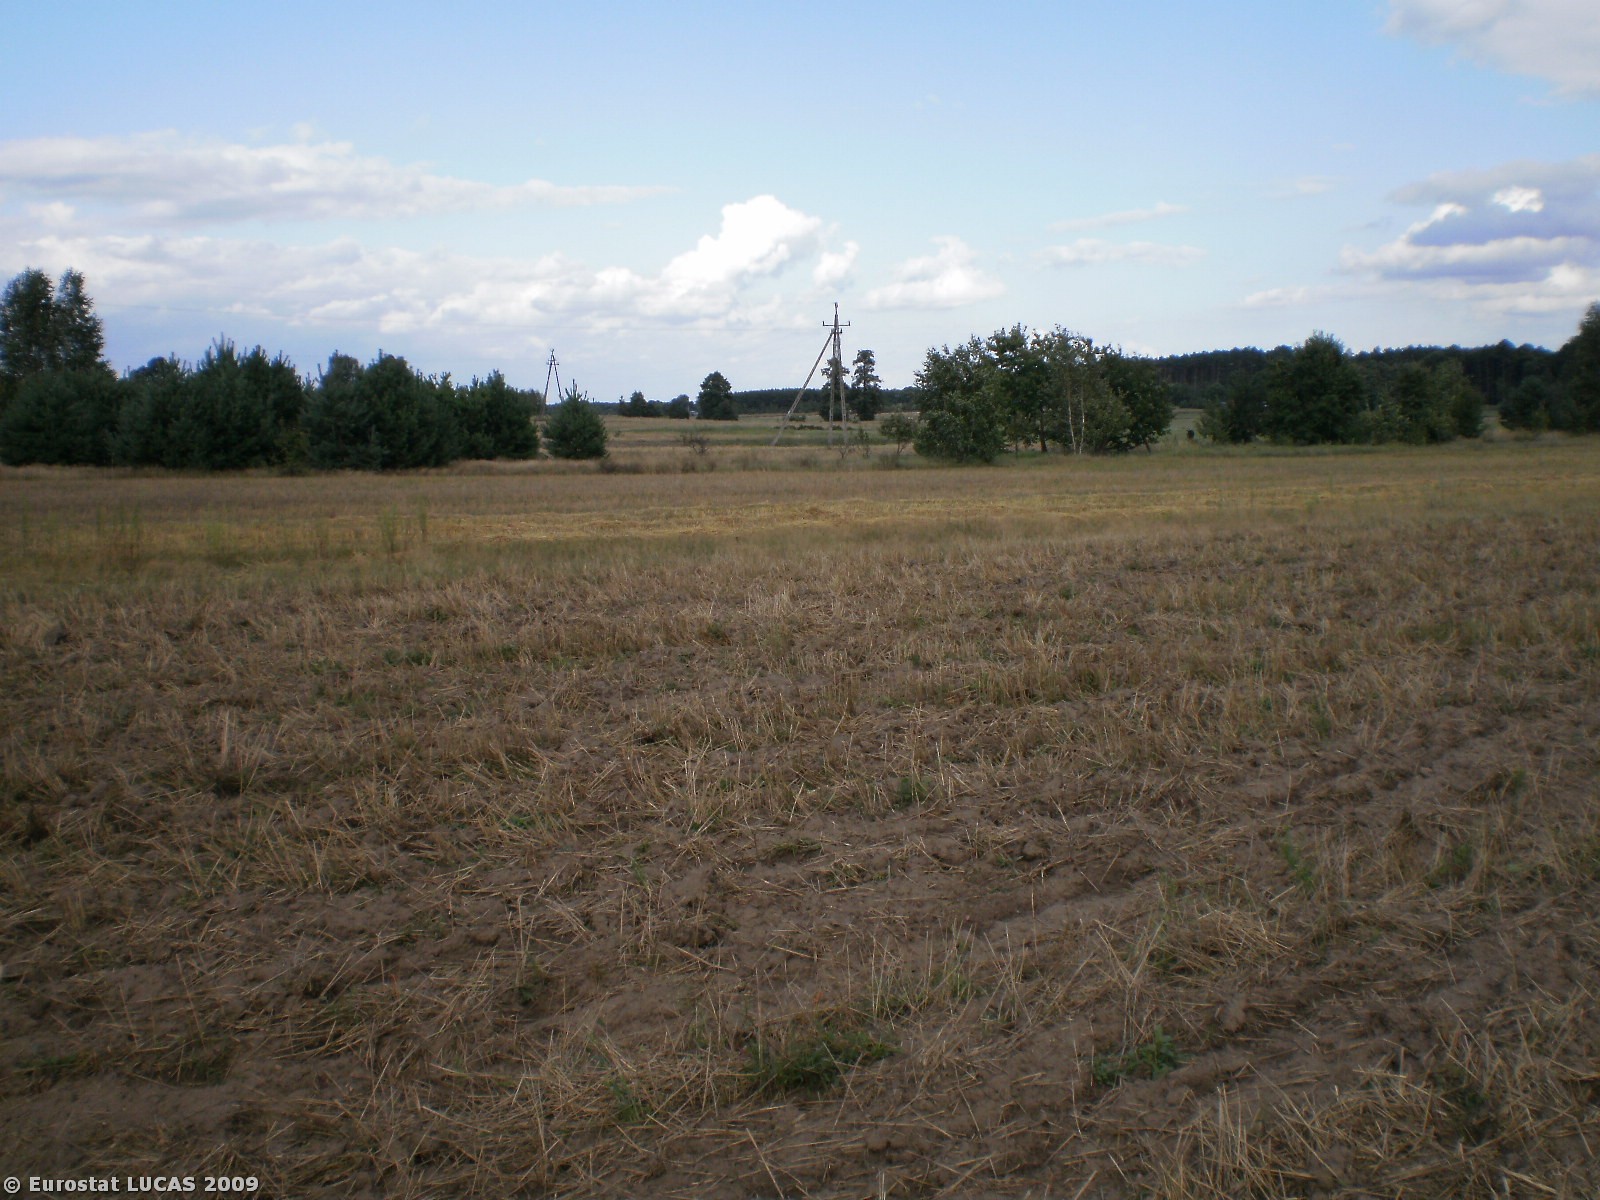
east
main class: Cropland
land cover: Rye
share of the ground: < 10 %
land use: Agriculture (excluding fallow land and kitchen gardens)
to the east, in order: Rye; Tracks; Oats; Grassland with sparse tree/shrub cover; Rye; Tracks; Grassland without tree/shrub cover
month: August
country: PL
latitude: 52.7525
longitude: 21.7741
